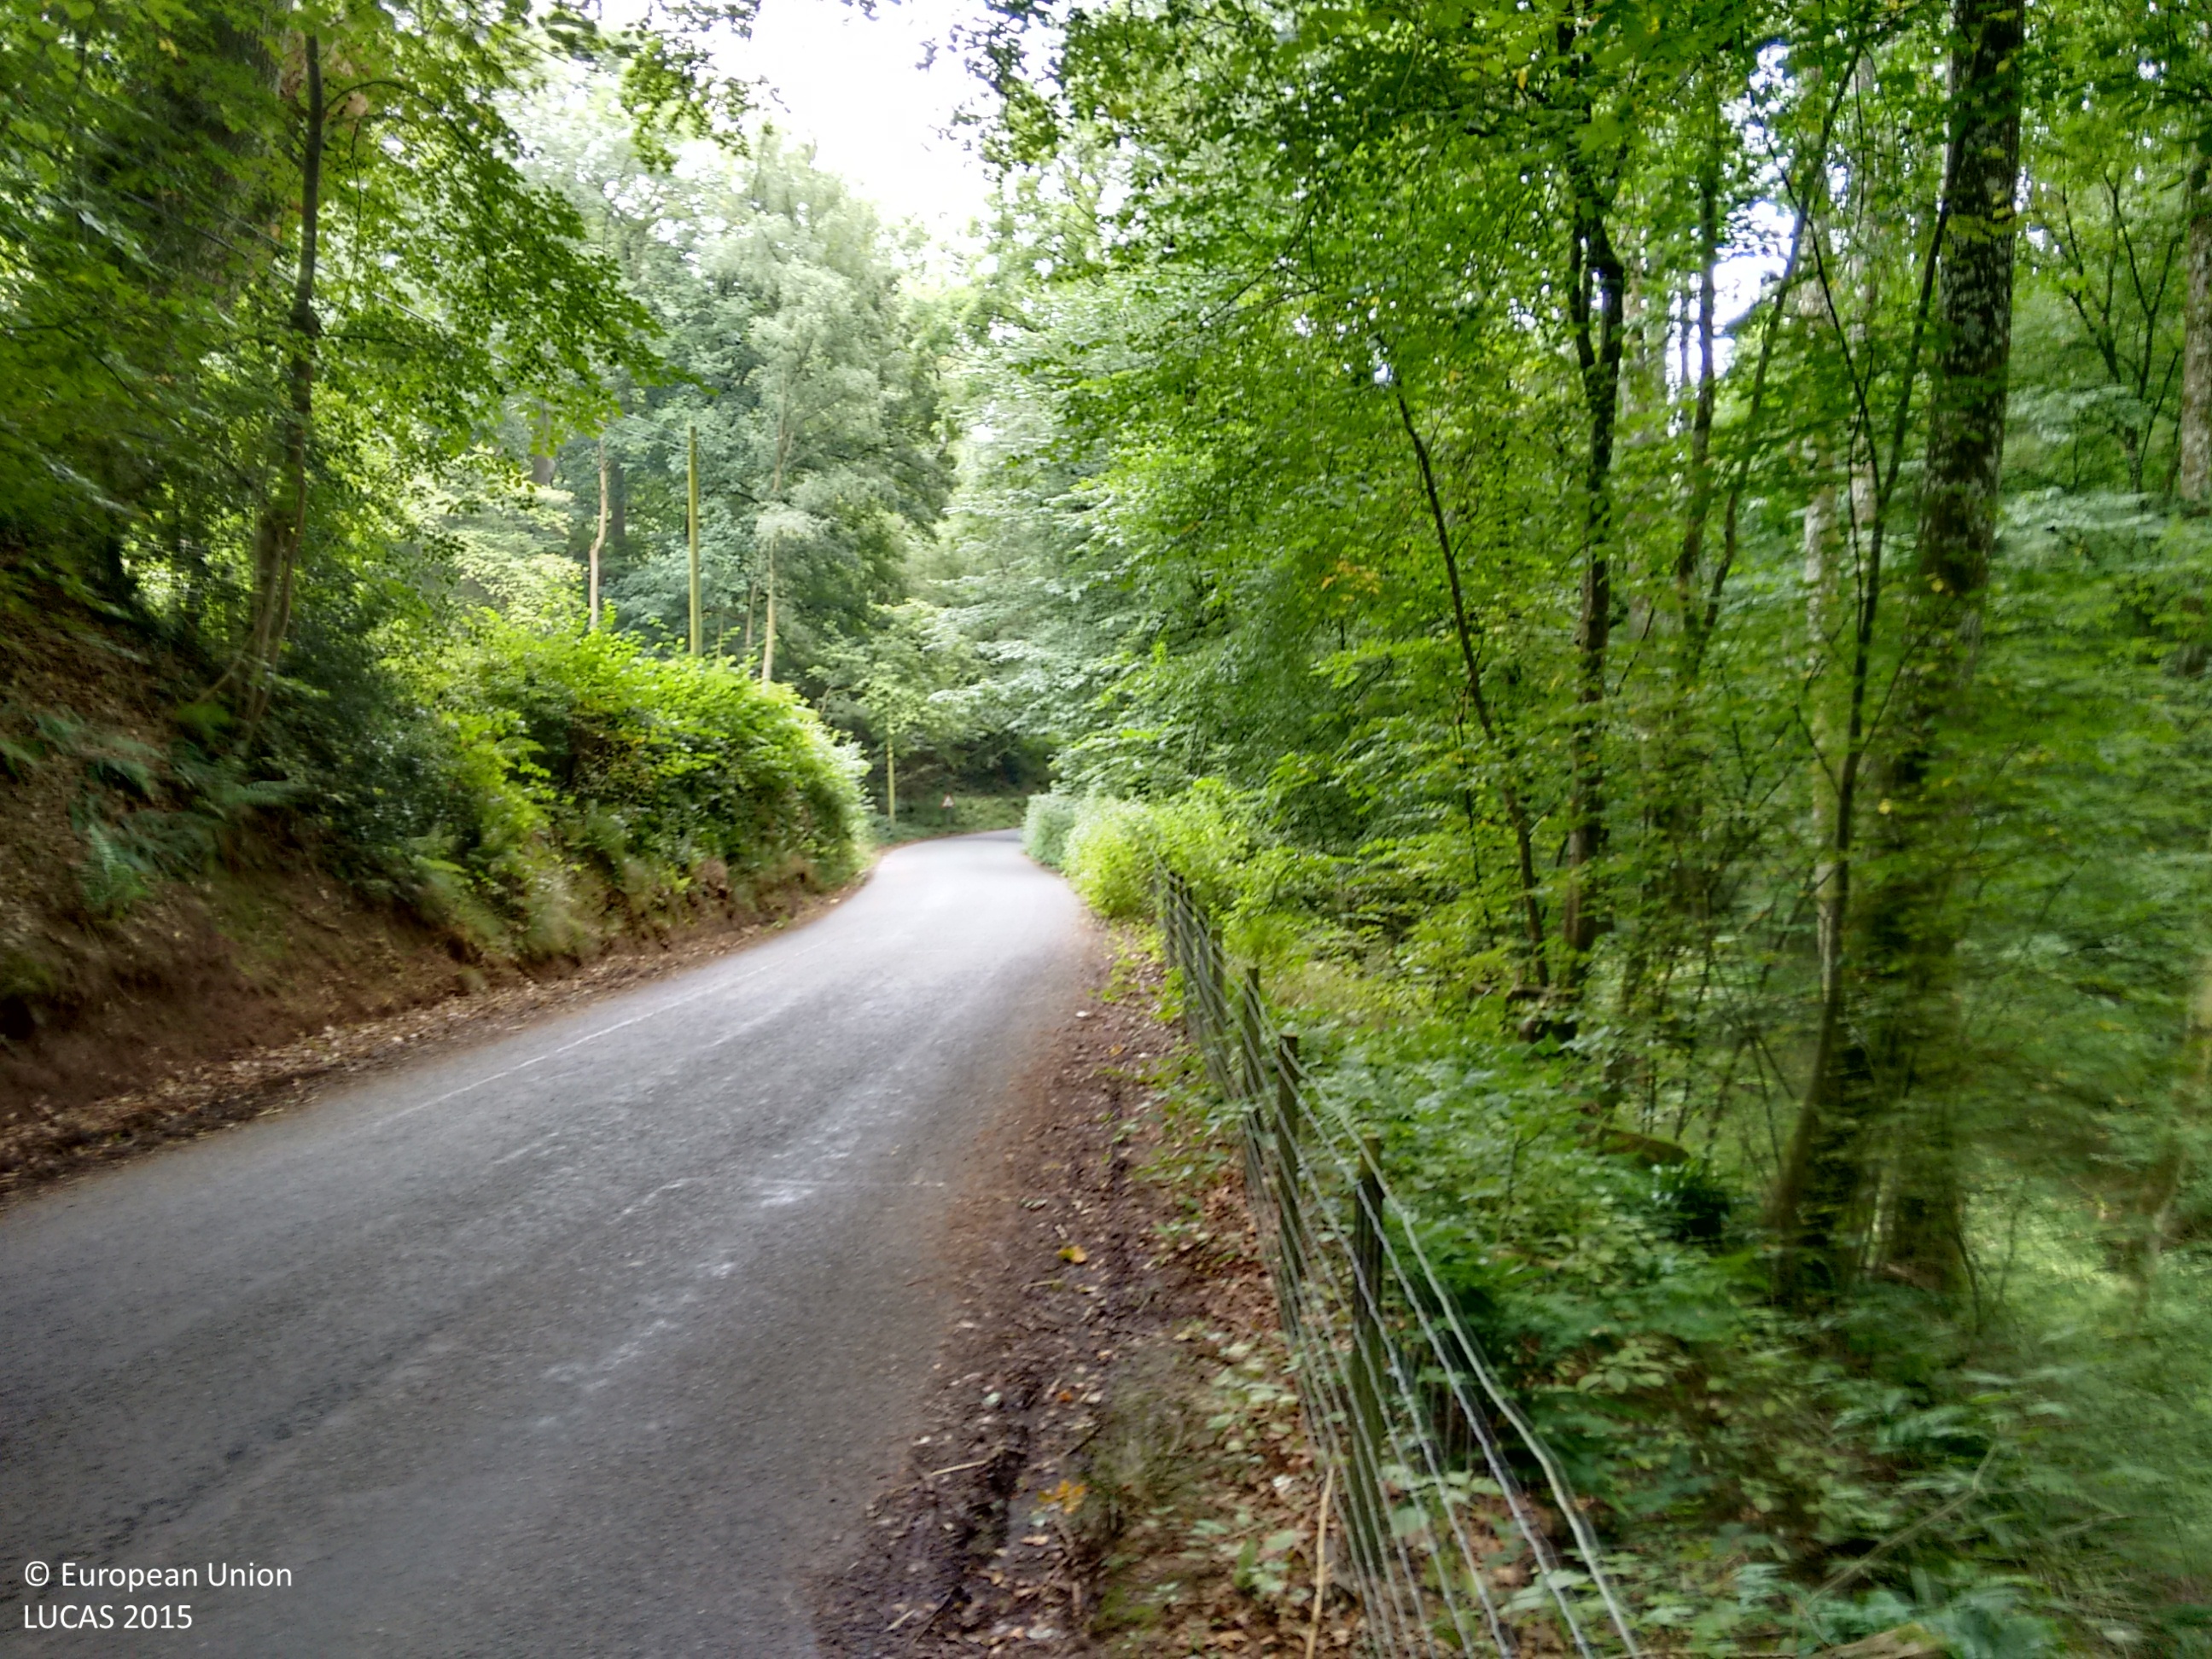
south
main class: Woodland
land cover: Broadleaved woodland
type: mesophytic deciduous forest
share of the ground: > 75 %
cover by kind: broadleaved forest trees 80 %, shrubs 20 %
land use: Semi-natural and natural areas not in use
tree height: > 5 m
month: September
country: GB
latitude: 52.0533
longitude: -3.2186
